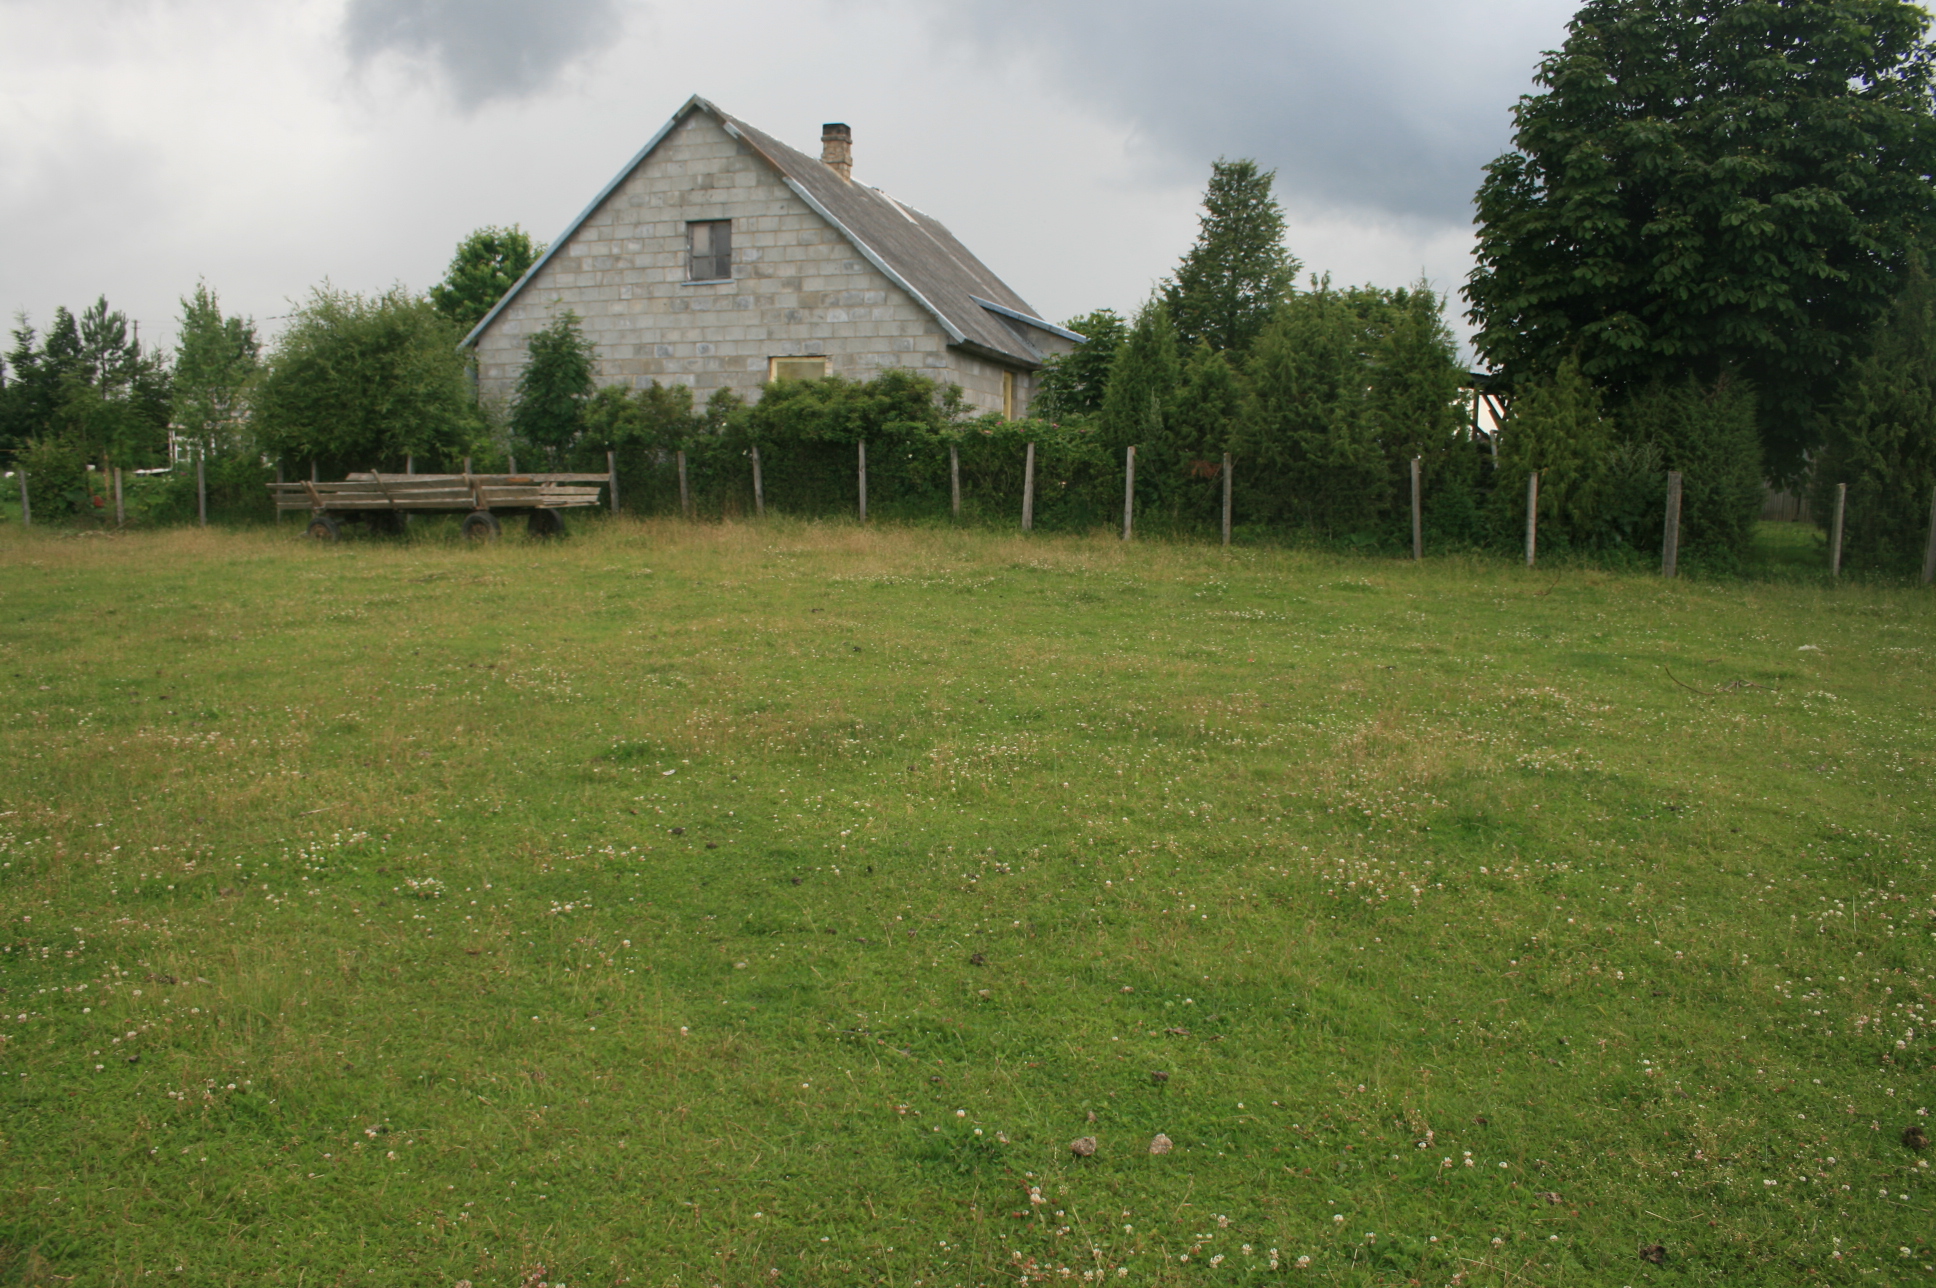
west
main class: Grassland
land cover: Grassland without tree/shrub cover
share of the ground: > 75 %
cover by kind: herbaceous plants 100 %
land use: Agriculture (excluding fallow land and kitchen gardens)
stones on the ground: < 10 %
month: July
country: LT
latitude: 56.0929
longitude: 22.0261
